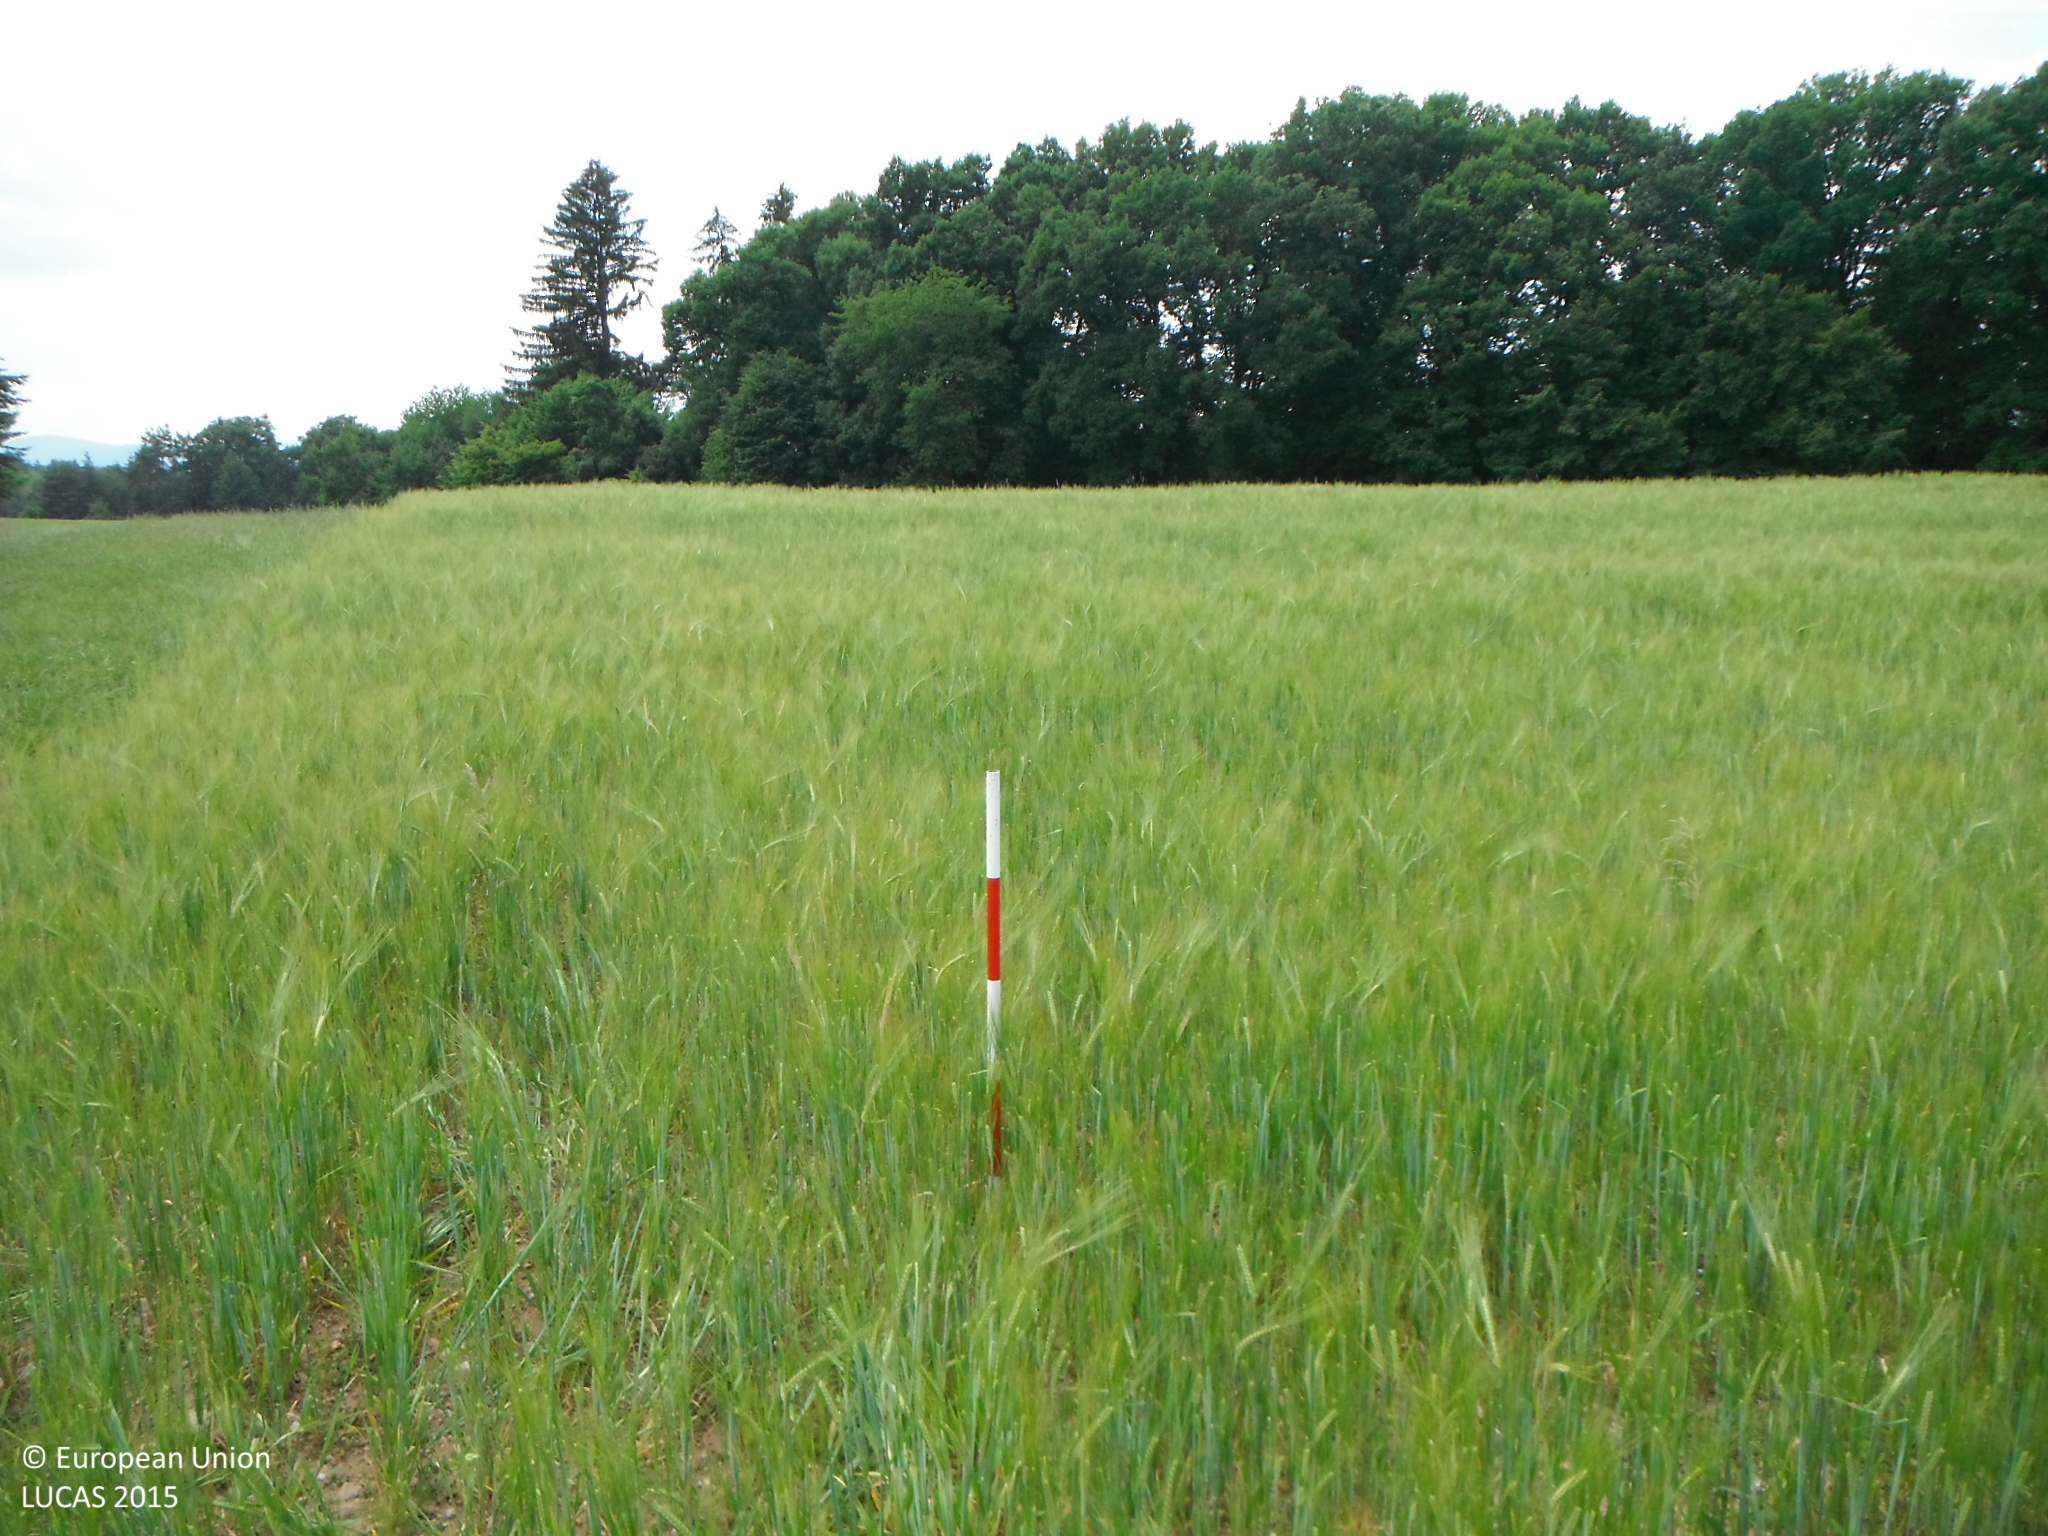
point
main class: Cropland
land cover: Barley
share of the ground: > 75 %
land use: Agriculture (excluding fallow land and kitchen gardens)
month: June
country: SK
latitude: 48.6185
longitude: 19.1790
